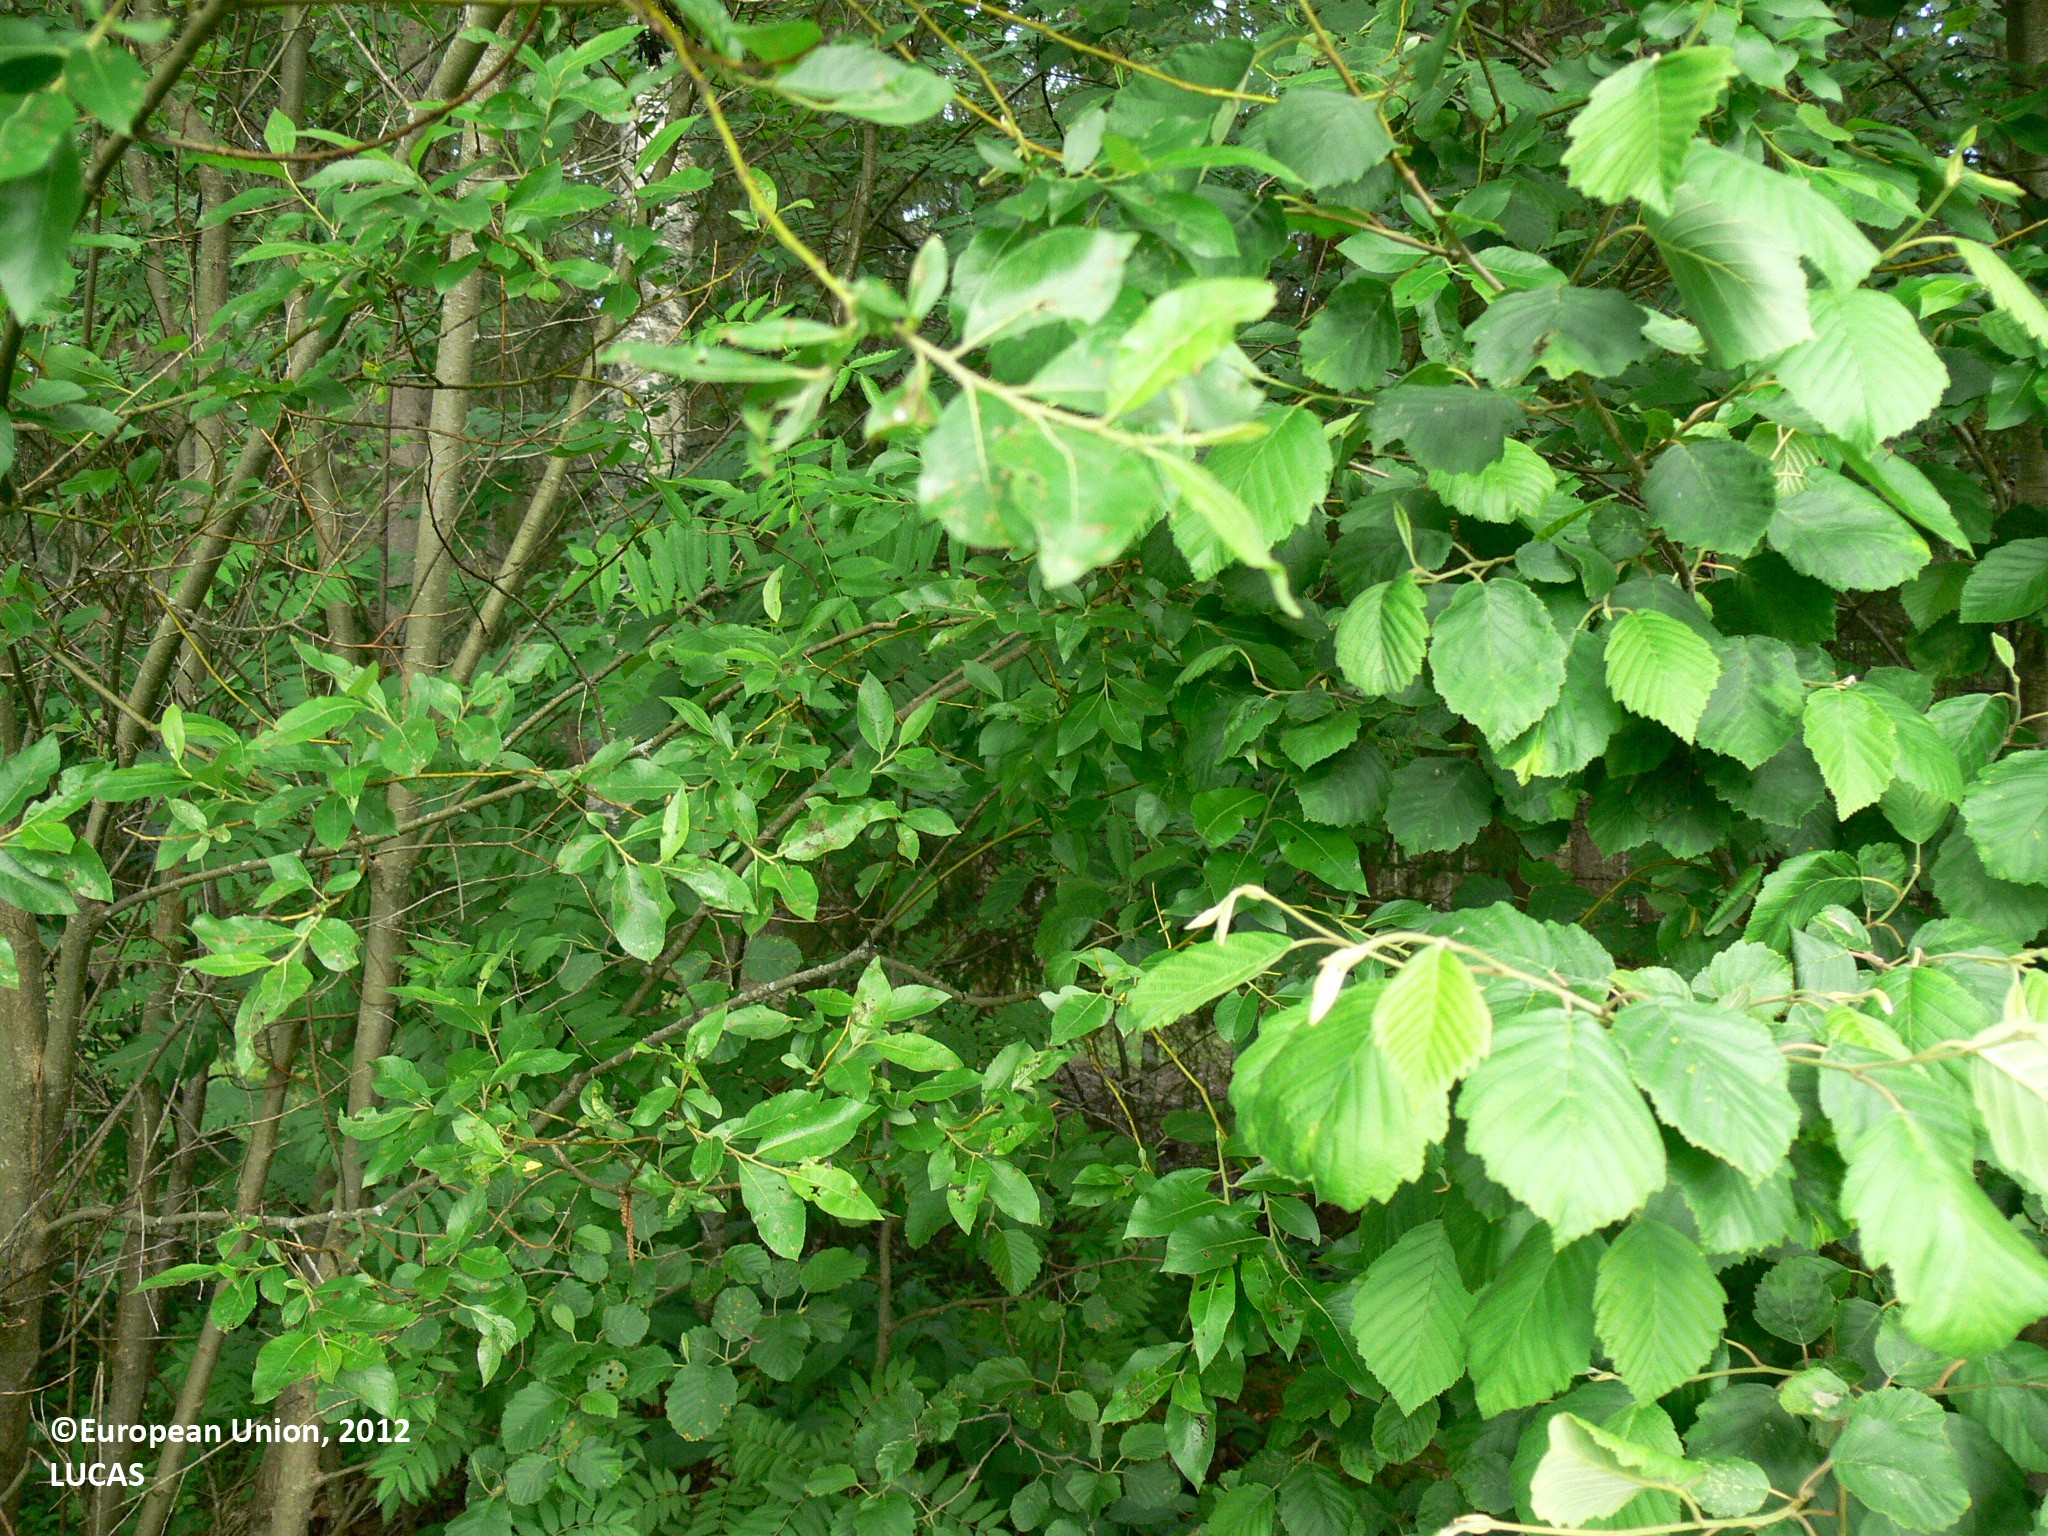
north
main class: Cropland
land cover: Oats
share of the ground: 50 - 75 %
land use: Agriculture (excluding fallow land and kitchen gardens)
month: June
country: FI
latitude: 62.4255
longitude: 29.5890
